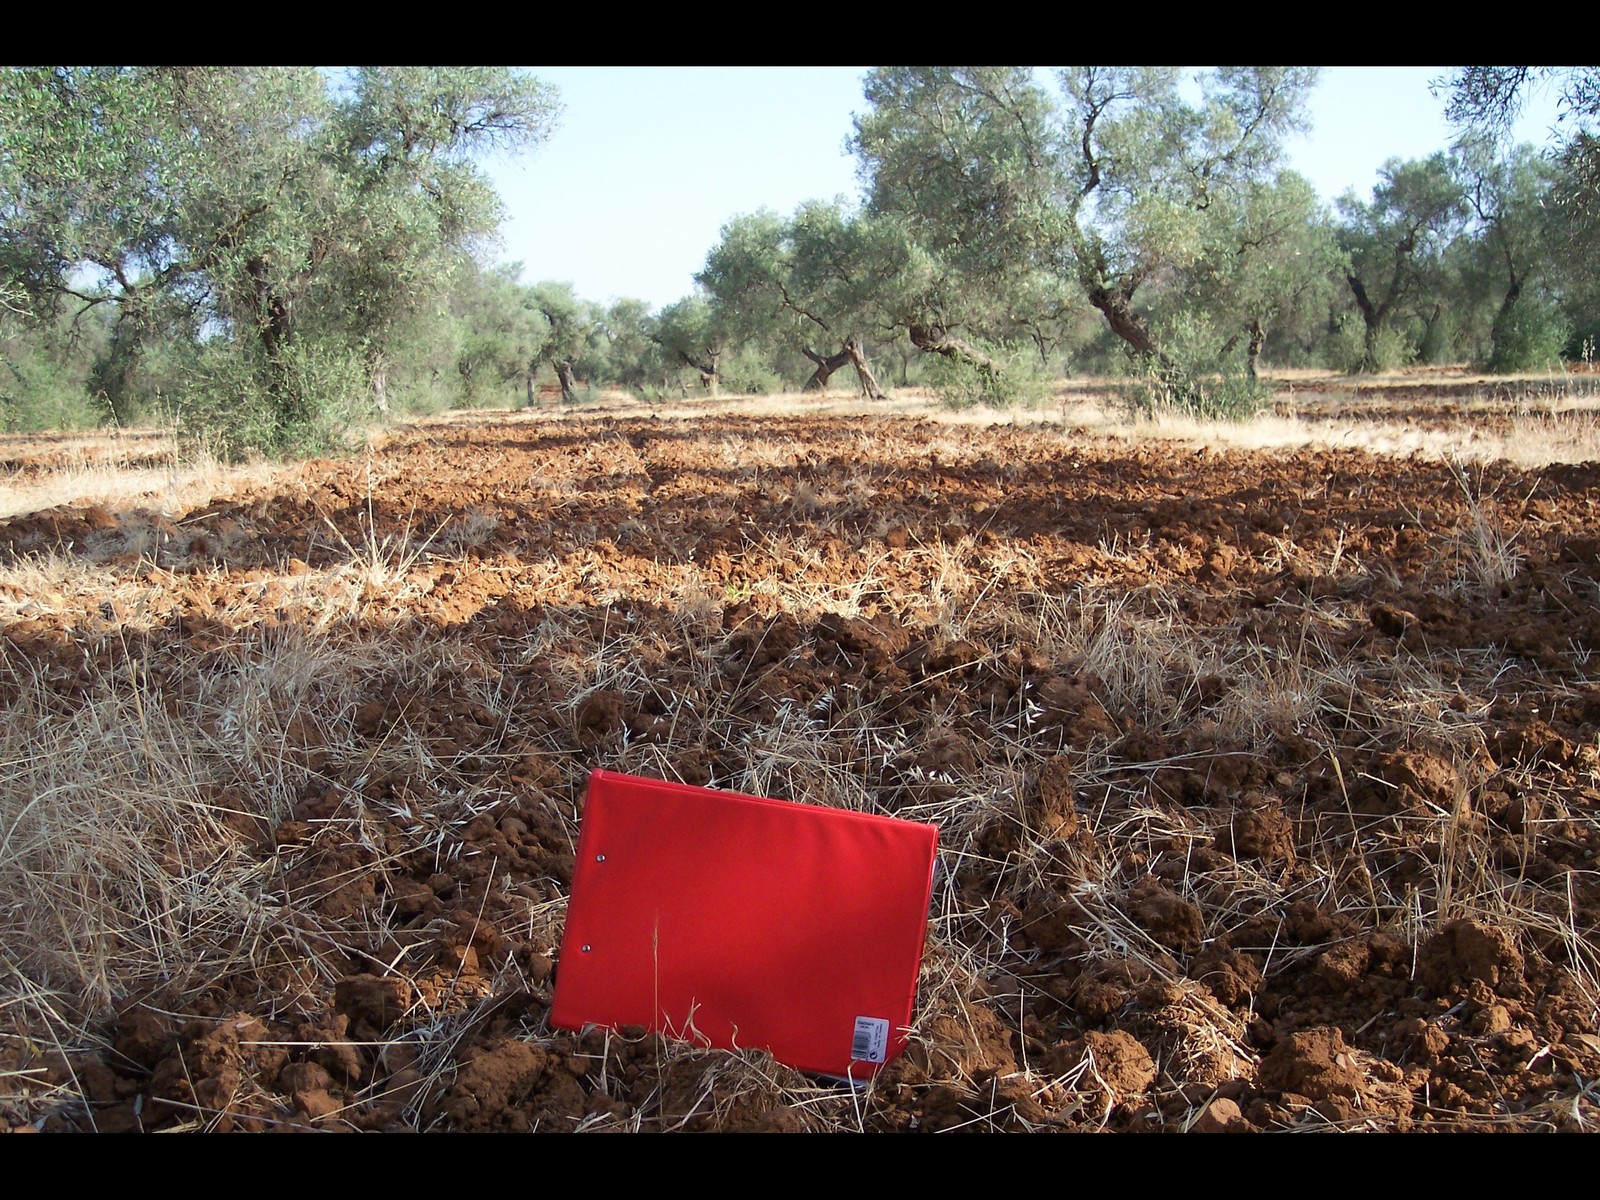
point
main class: Cropland
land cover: Olive groves
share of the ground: 10 - 25 %
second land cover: Other bare soil
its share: > 75 %
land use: Agriculture (excluding fallow land and kitchen gardens)
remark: Harvested field
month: June
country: ES
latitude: 37.3225
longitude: -5.8987
